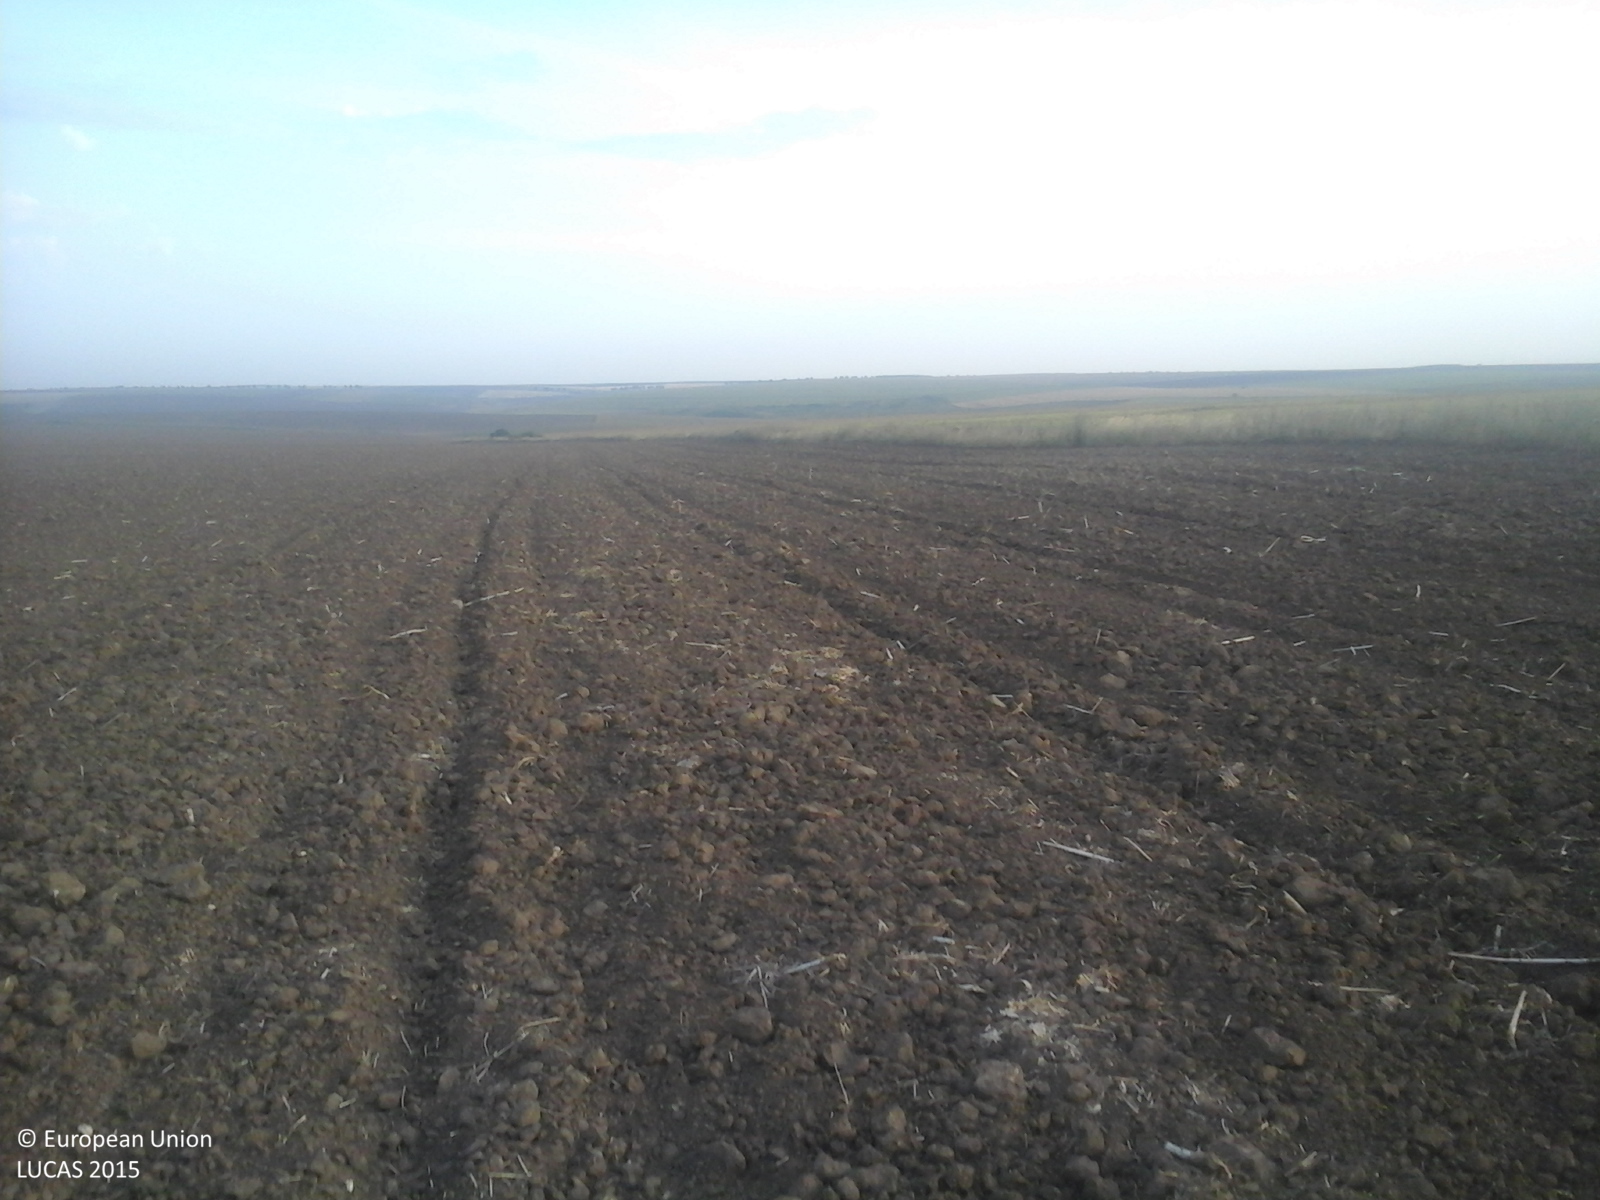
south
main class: Cropland
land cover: Rape and turnip rape
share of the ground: < 10 %
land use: Agriculture (excluding fallow land and kitchen gardens)
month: August
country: RO
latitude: 44.1235
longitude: 28.1149
